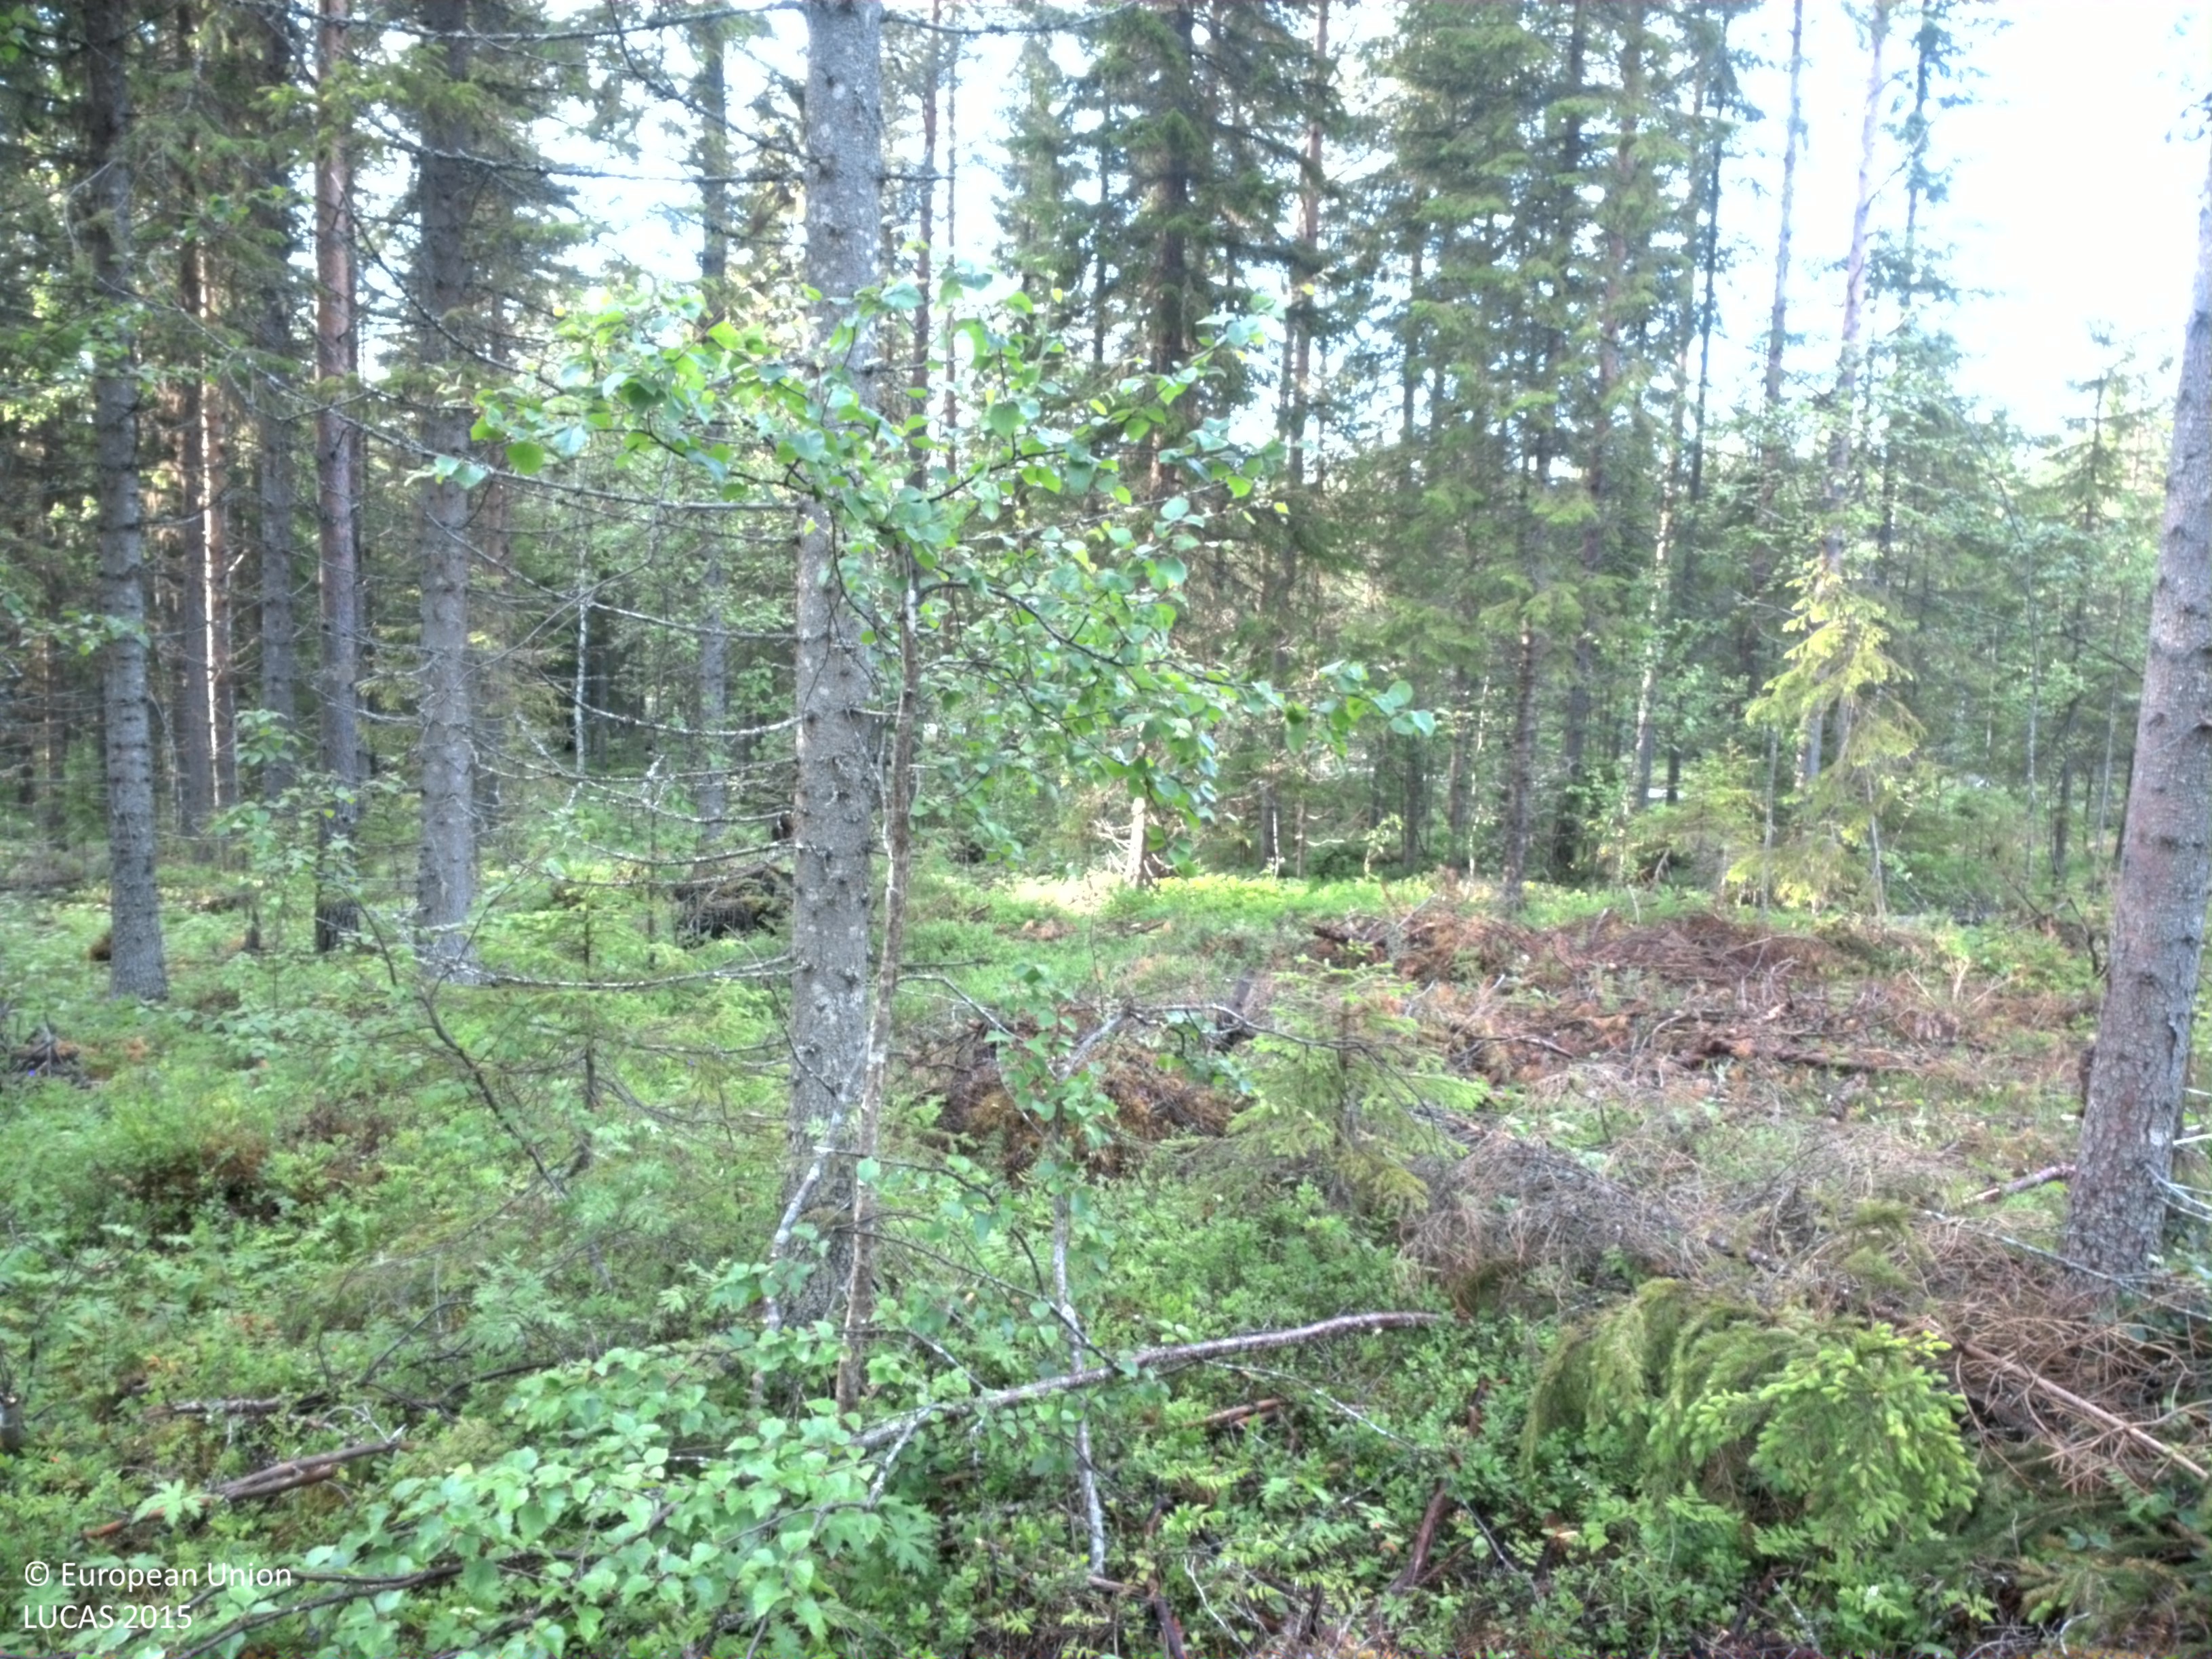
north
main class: Woodland
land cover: Pine dominated coniferous woodland
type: boreal forest
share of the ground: 25 - 50 %
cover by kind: coniferous forest trees 40 %, shrubs 40 %, broadleaved forest trees 10 %, herbaceous plants 10 %
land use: Forestry
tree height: > 5 m
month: July
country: SE
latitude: 64.6458
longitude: 18.4437
